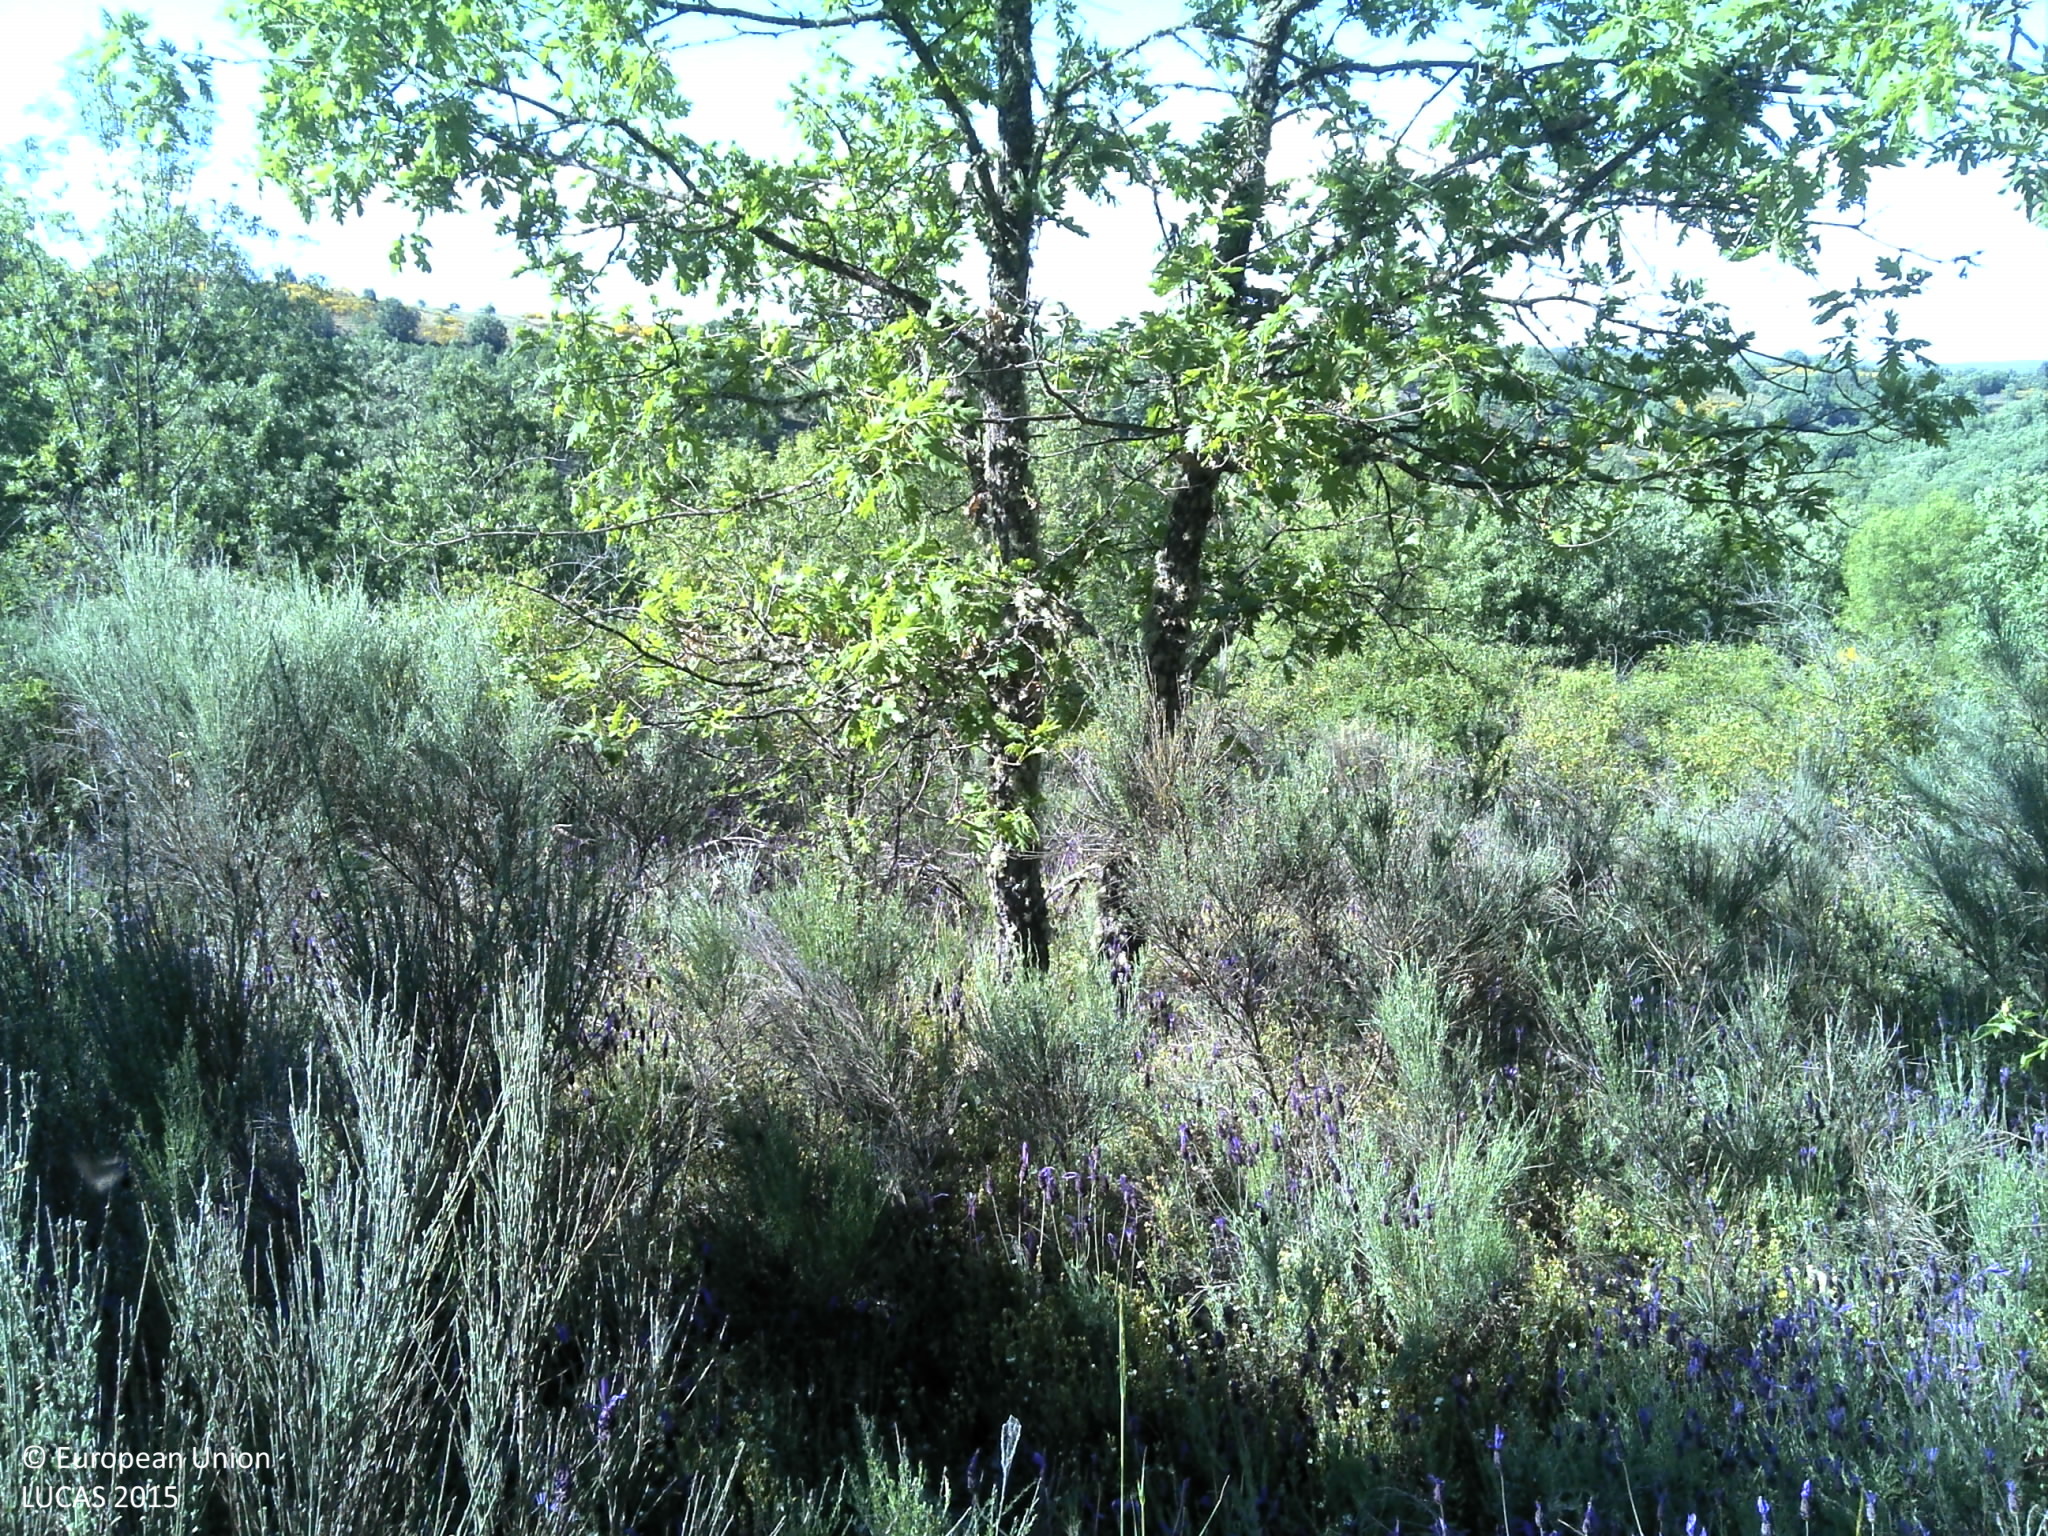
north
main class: Woodland
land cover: Other mixed woodland
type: acidophilous oak and oak-birch forest
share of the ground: 10 - 25 %
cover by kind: shrubs 35 %, herbaceous plants 20 %, unconsolidated bare surface 20 %, broadleaved forest trees 15 %, coniferous forest trees 10 %
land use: Forestry
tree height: > 5 m
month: May
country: PT
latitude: 41.6290
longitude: -6.3415
